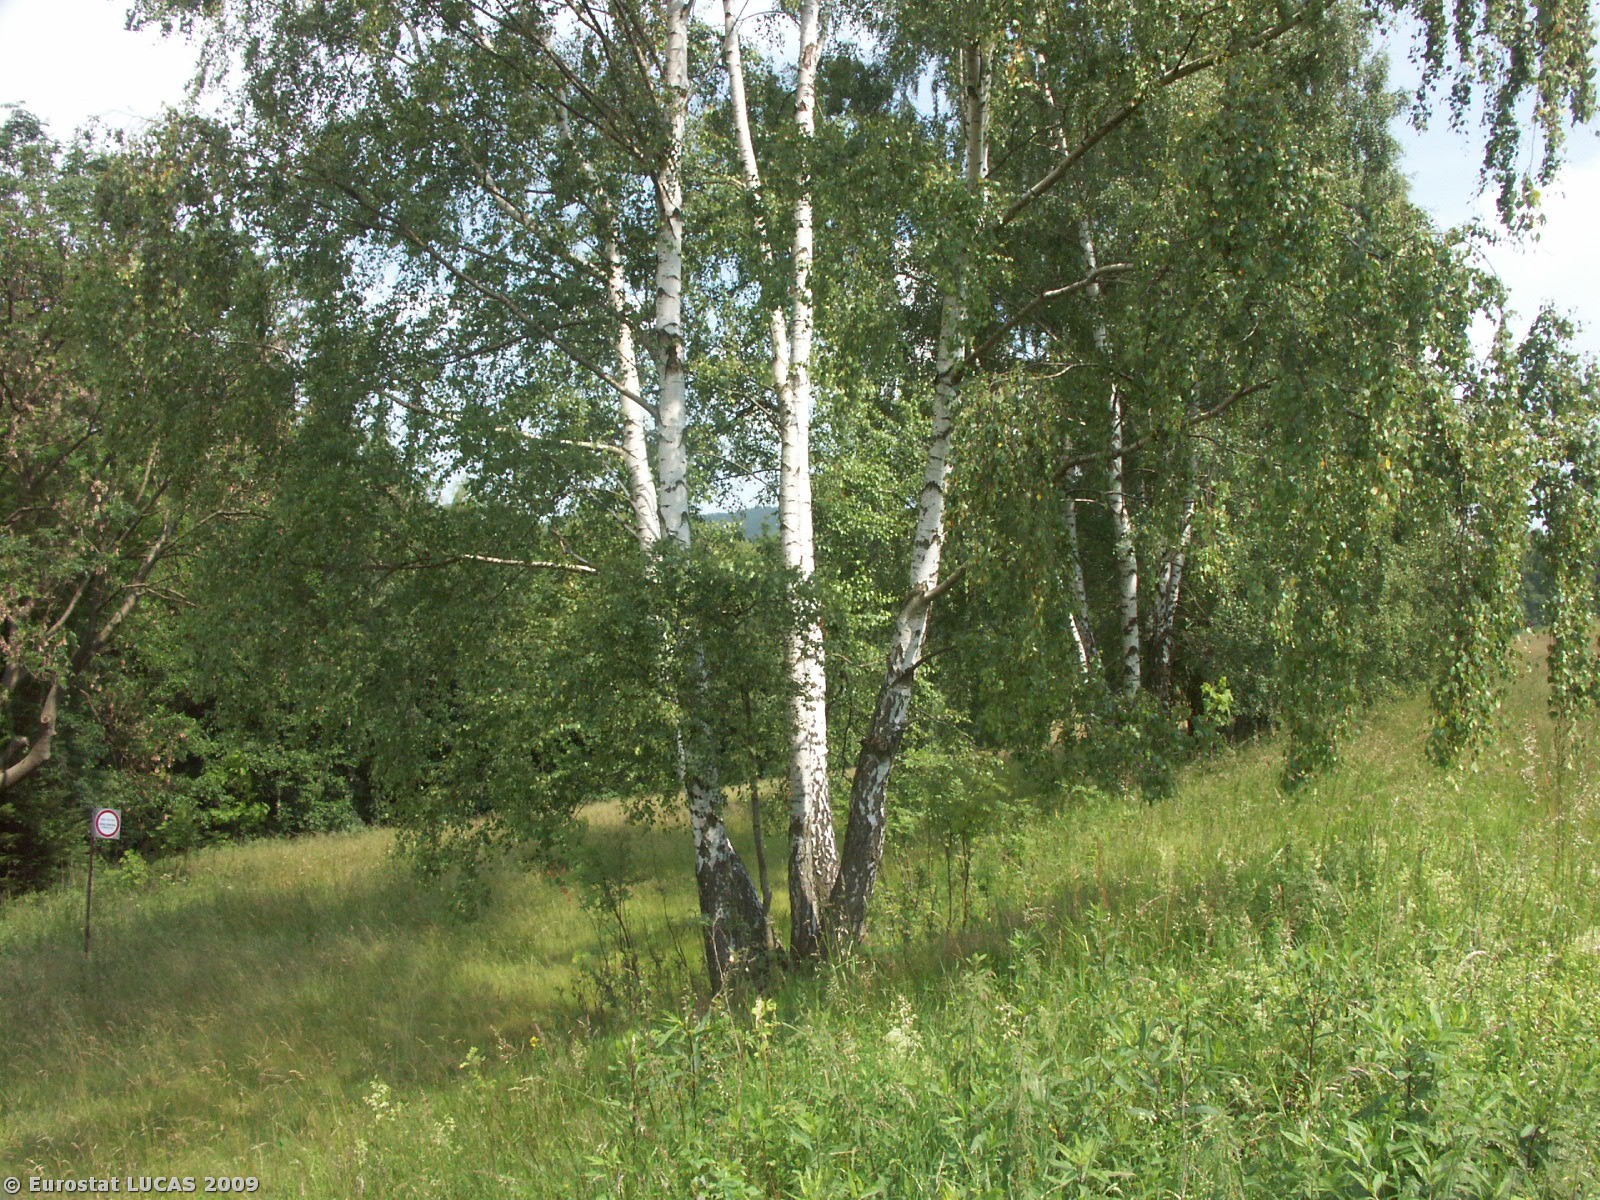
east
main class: Grassland
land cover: Grassland without tree/shrub cover
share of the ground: > 75 %
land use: Agriculture (excluding fallow land and kitchen gardens)
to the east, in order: Grassland without tree/shrub cover; Broadleaved woodland; Grassland without tree/shrub cover; Mixed woodland; Grassland with sparse tree/shrub cover; Broadleaved woodland; Tracks; Broadleaved woodland; Rivers and streams; Broadleaved woodland; Tracks; Grassland without tree/shrub cover
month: July
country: CZ
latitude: 50.0252
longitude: 16.6664
